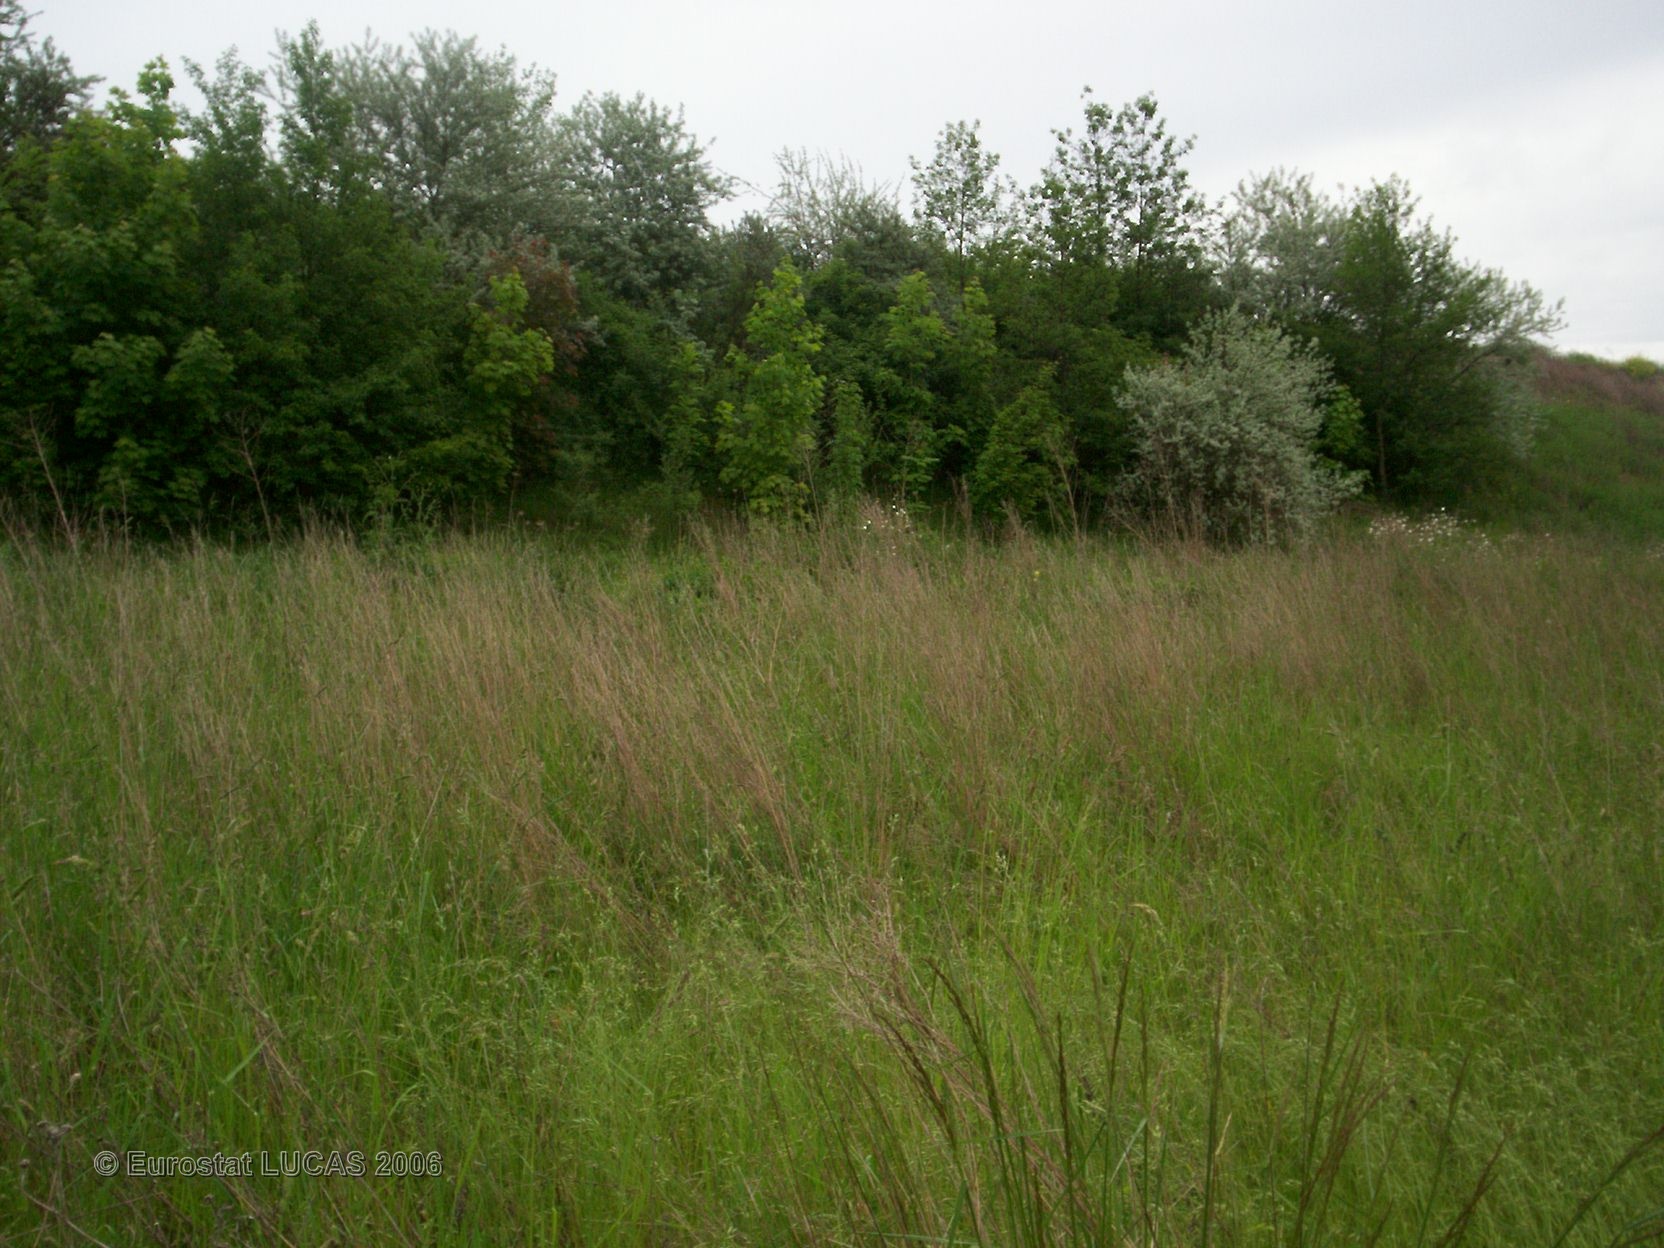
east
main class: Grassland
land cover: Grassland without tree/shrub cover
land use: Fallow land
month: May
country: FR
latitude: 48.6516
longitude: 2.7280
